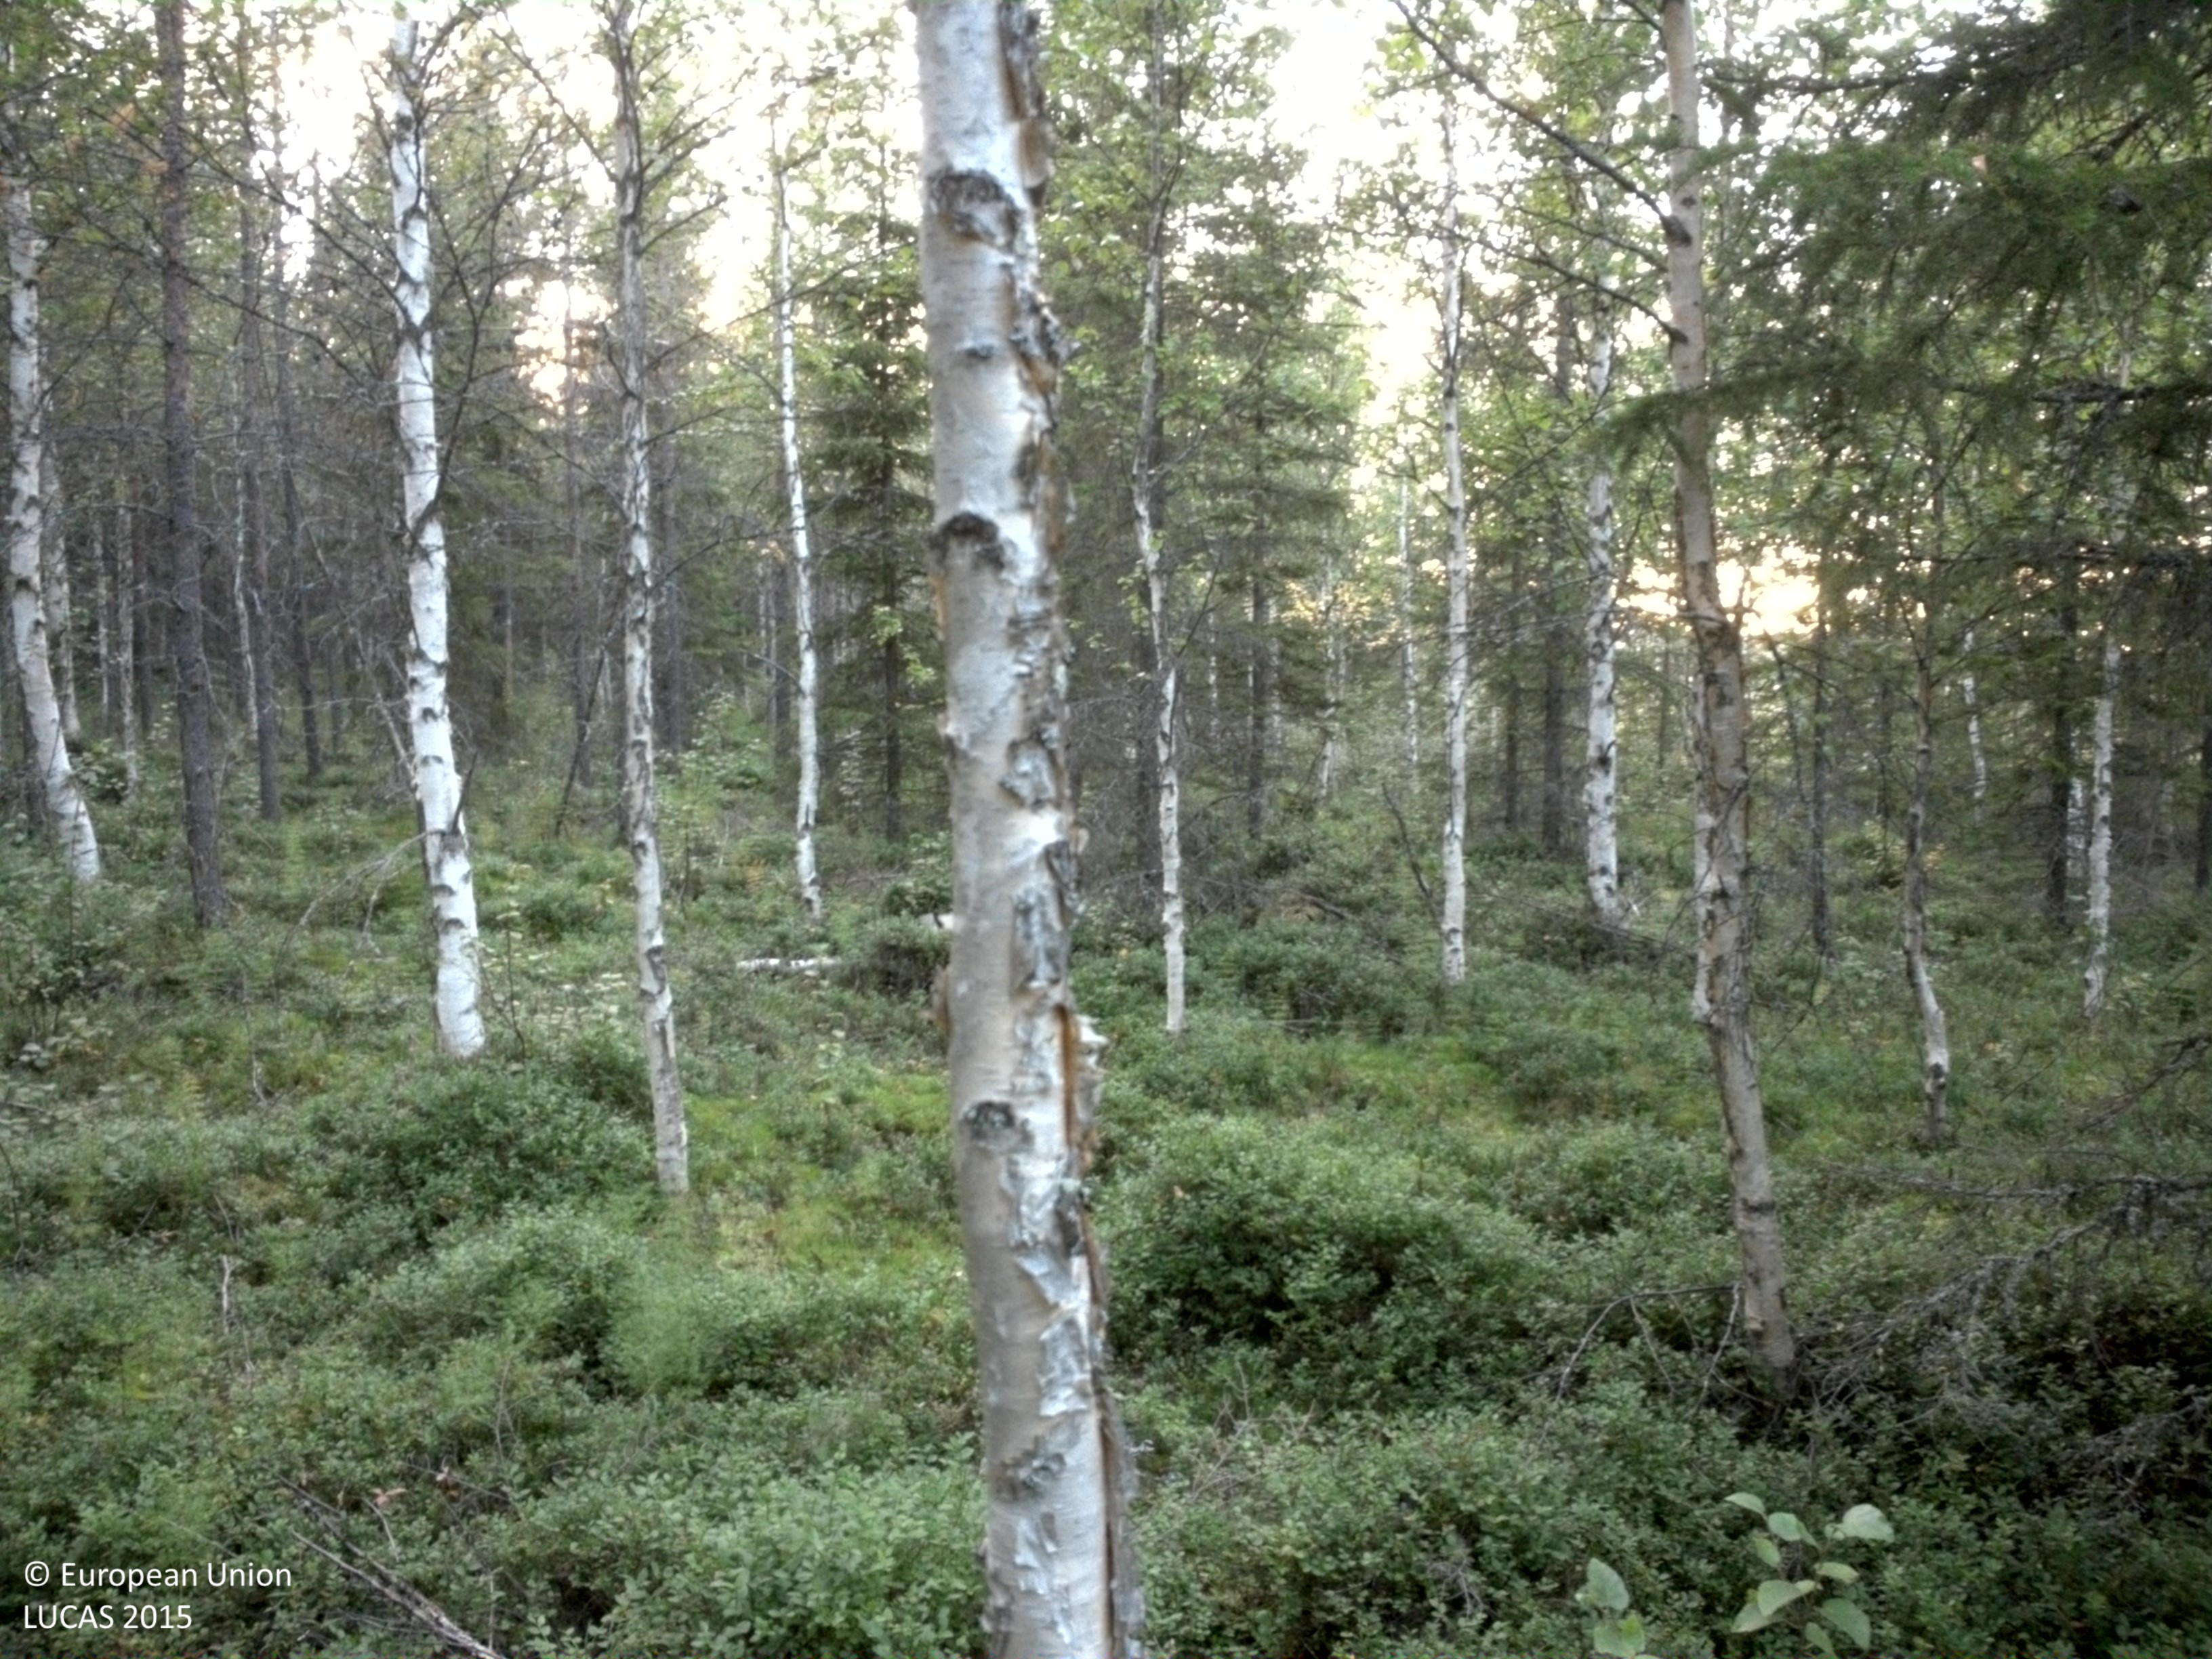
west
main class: Woodland
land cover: Spruce dominated mixed woodland
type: boreal forest
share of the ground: 50 - 75 %
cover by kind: coniferous forest trees 45 %, shrubs 30 %, broadleaved forest trees 15 %, lichens and mosses 10 %
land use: Forestry
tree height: > 5 m
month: August
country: SE
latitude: 64.3732
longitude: 18.7771
